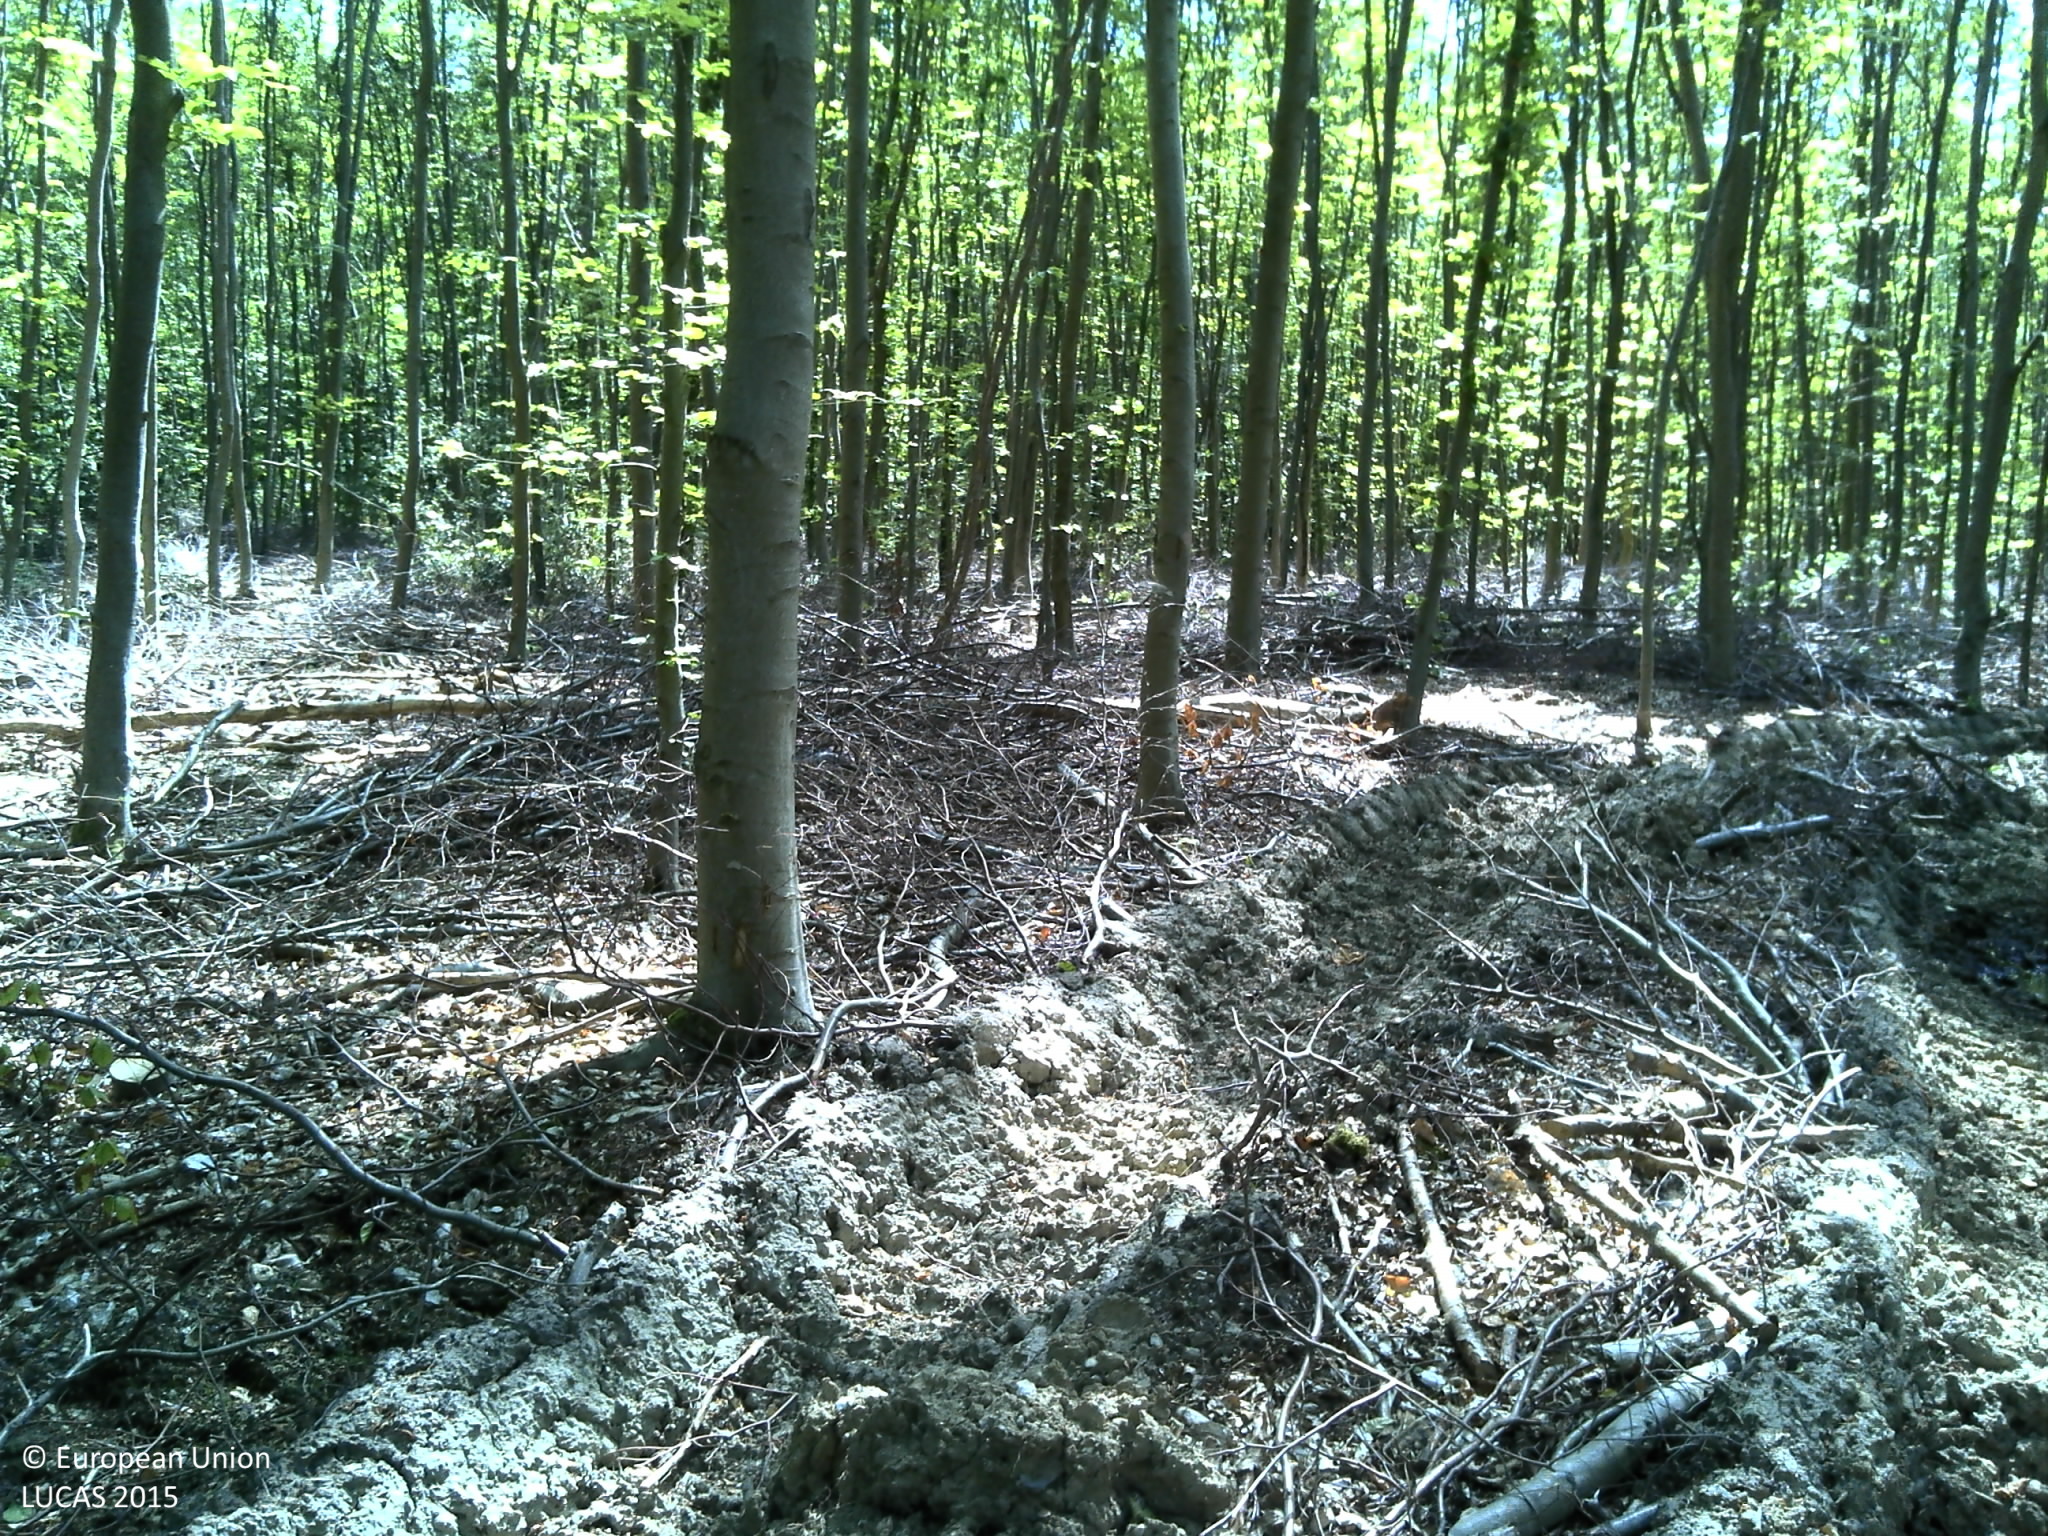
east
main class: Woodland
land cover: Broadleaved woodland
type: beech forest
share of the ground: > 75 %
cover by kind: broadleaved forest trees 90 %, consolidated bare surface 10 %
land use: Forestry
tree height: > 5 m
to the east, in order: Broadleaved woodland
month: June
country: FR
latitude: 49.5098
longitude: 1.0982
